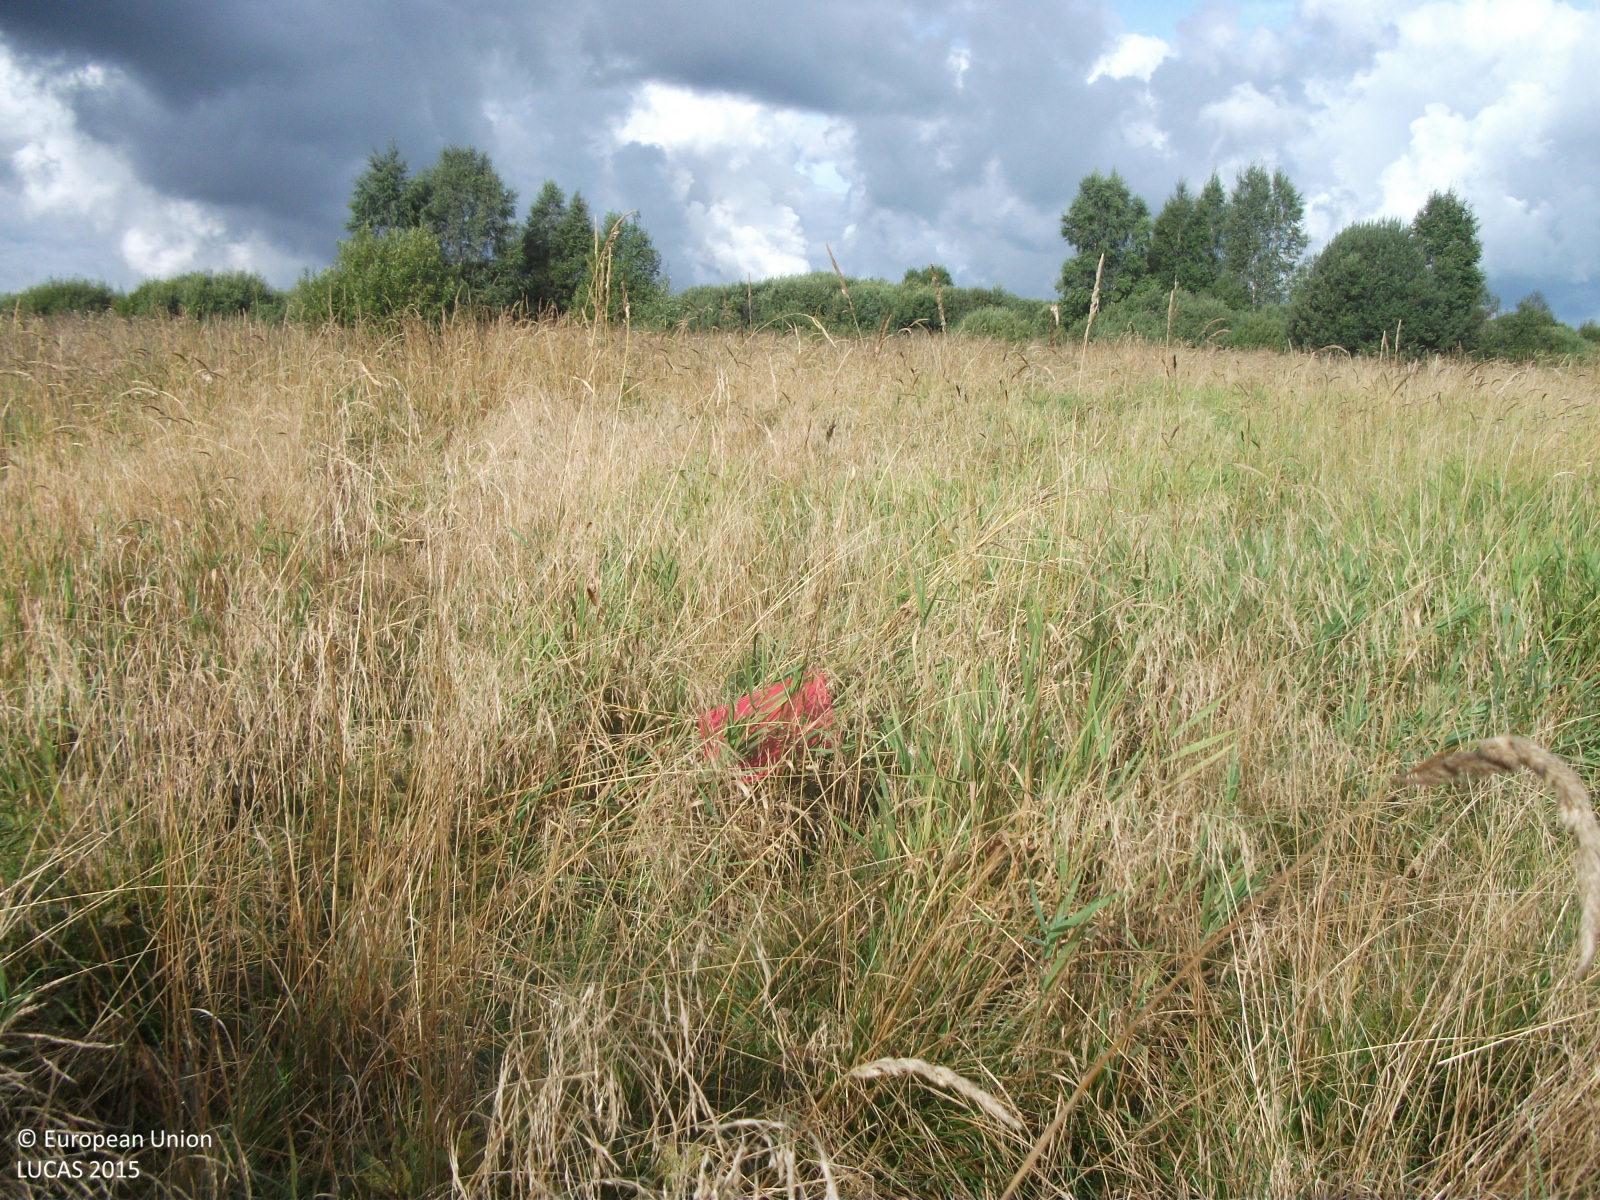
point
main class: Grassland
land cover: Spontaneously vegetated surfaces
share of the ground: > 75 %
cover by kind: herbaceous plants 95 %, shrubs 5 %
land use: Semi-natural and natural areas not in use
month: September
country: LV
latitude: 57.5846
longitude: 24.7310
